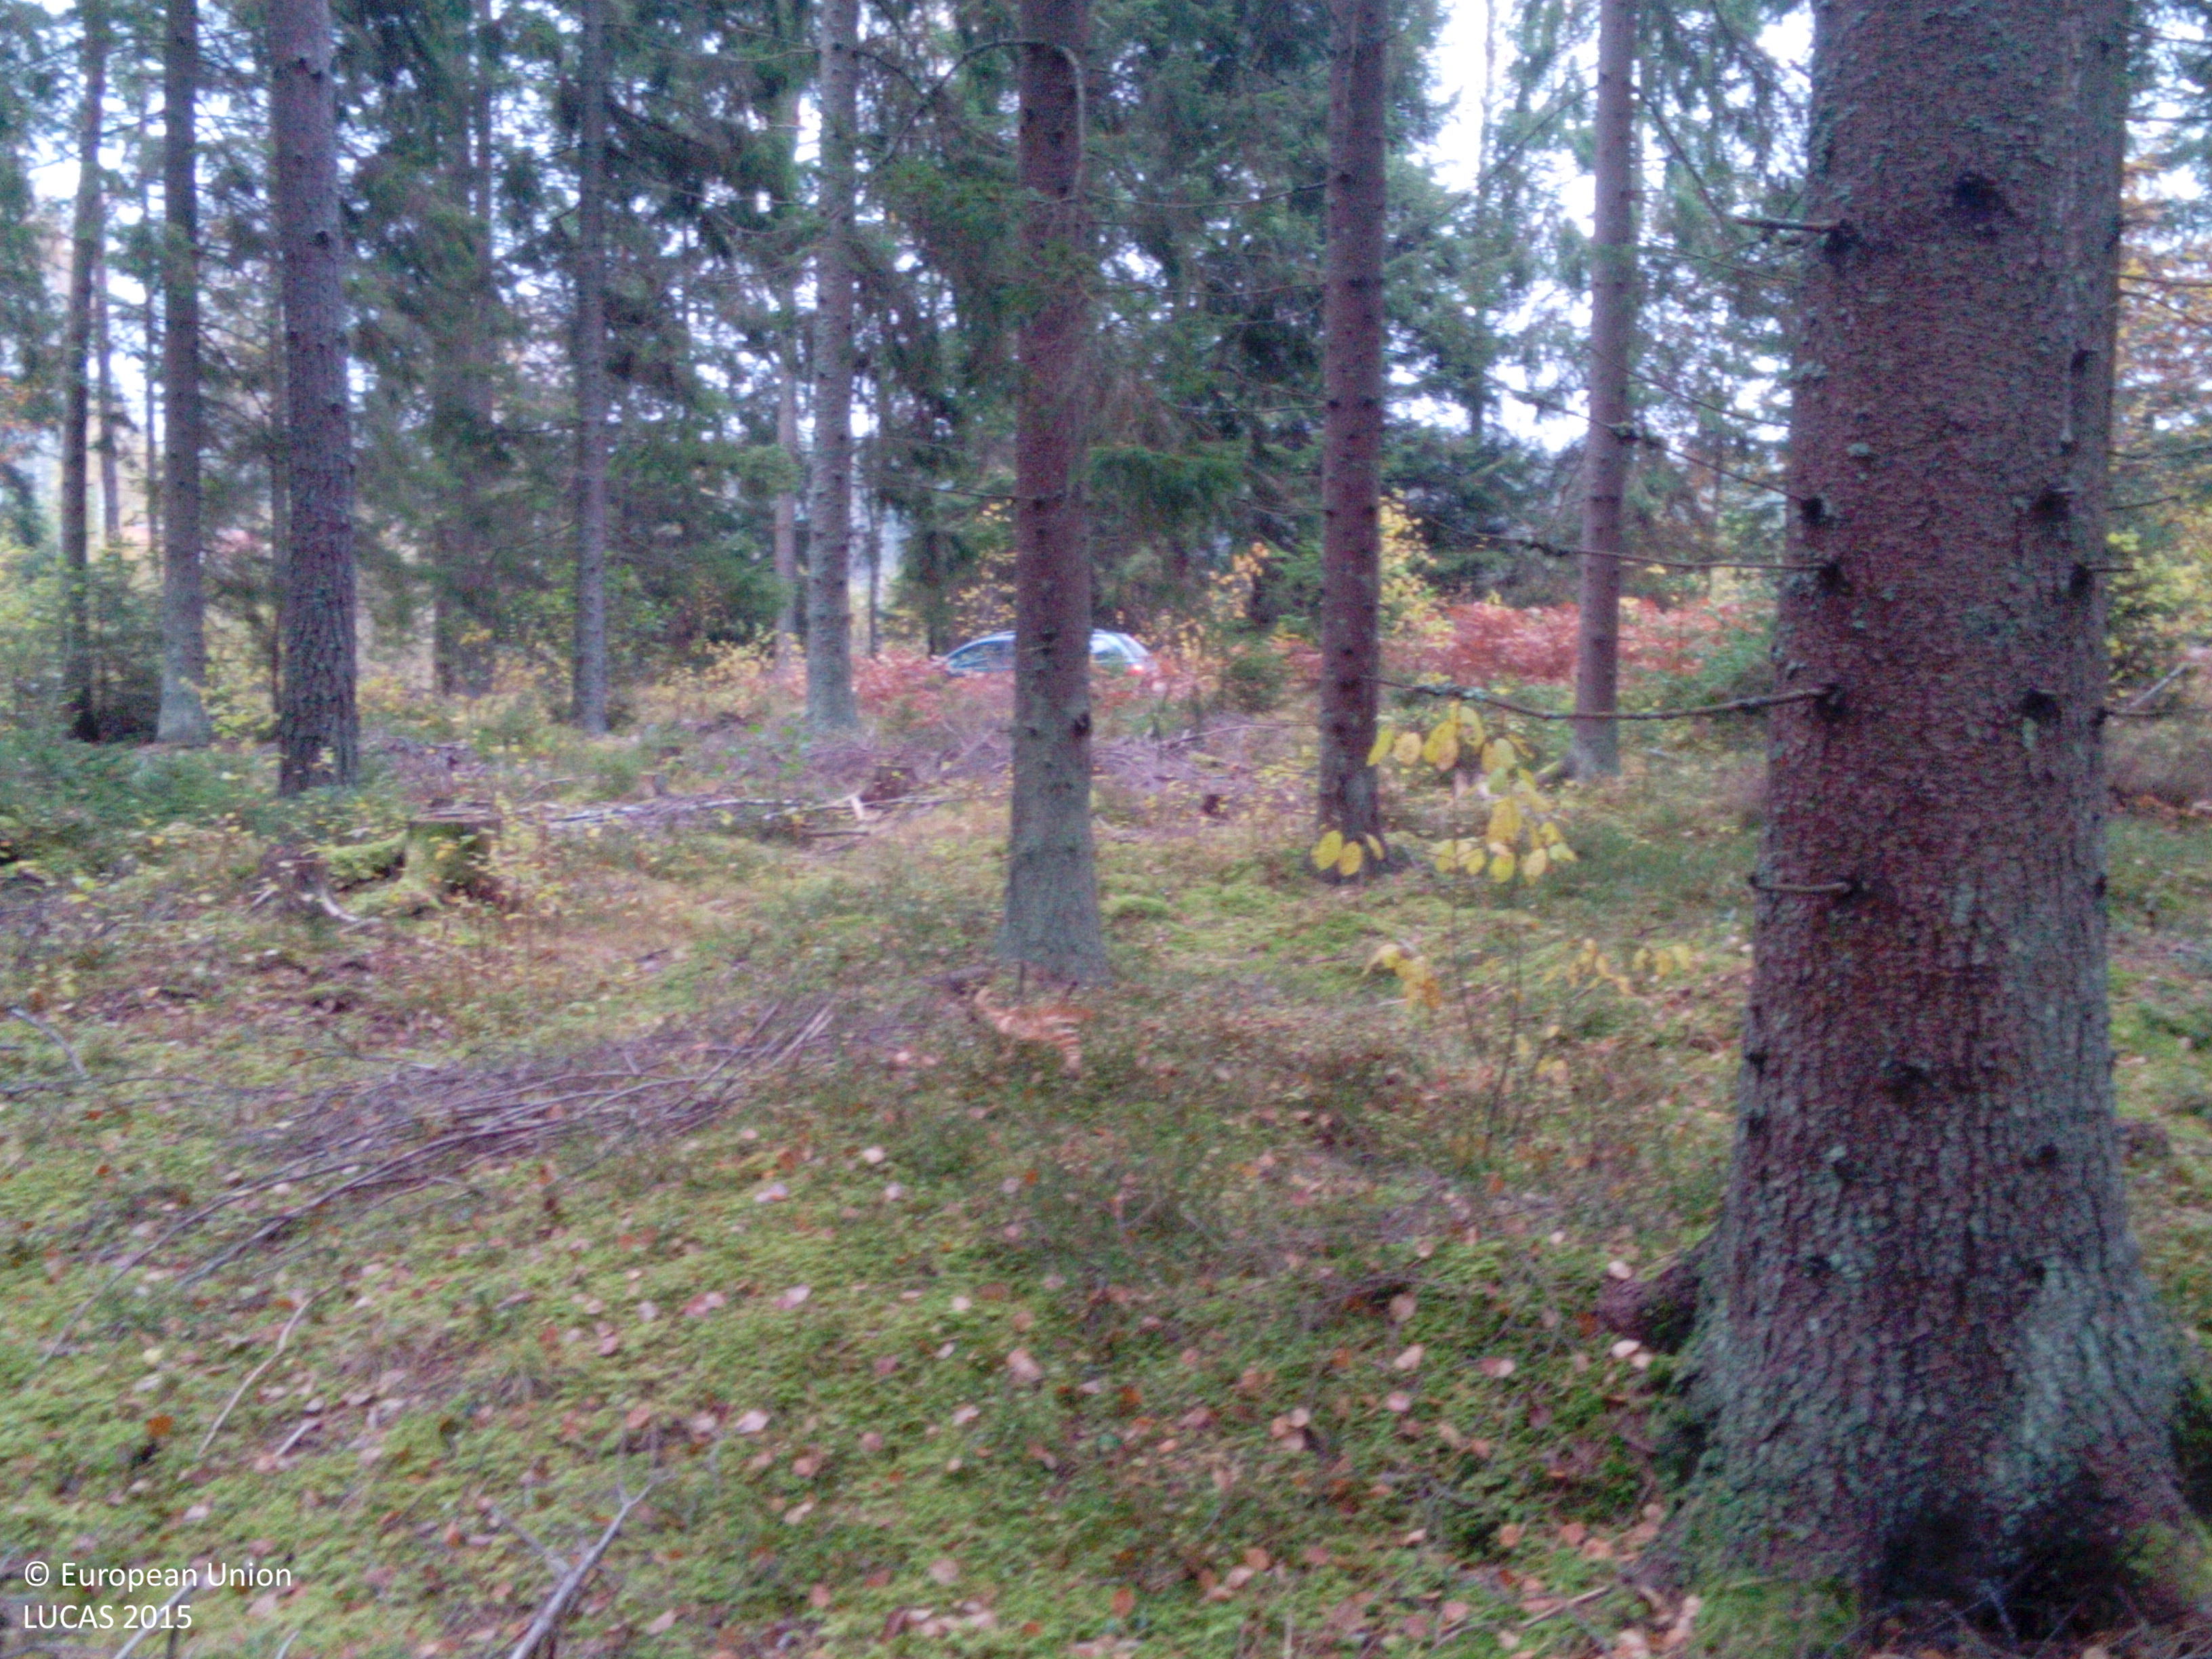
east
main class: Woodland
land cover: Spruce dominated coniferous woodland
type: boreal forest
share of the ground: > 75 %
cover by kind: coniferous forest trees 75 %, lichens and mosses 15 %, broadleaved forest trees 10 %
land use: Forestry
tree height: > 5 m
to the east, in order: Spruce dominated coniferous woodland; Grass margins; Paved roads, cycling and walking lanes; Grass margins; Spruce dominated coniferous woodland; Broadleaved woodland; Ditches and canals; Broadleaved woodland; Ditches and canals; Grassland with sparse tree/shrub cover; Broadleaved woodland; Grassland with sparse tree/shrub cover; Ditches and canals; Spontaneously vegetated surfaces; Electric lines; Spontaneously vegetated surfaces; Broadleaved woodland; Ditches and canals; Shruby margins; Grassland without tree/shrub cover
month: October
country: SE
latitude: 59.0699
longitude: 16.1856
